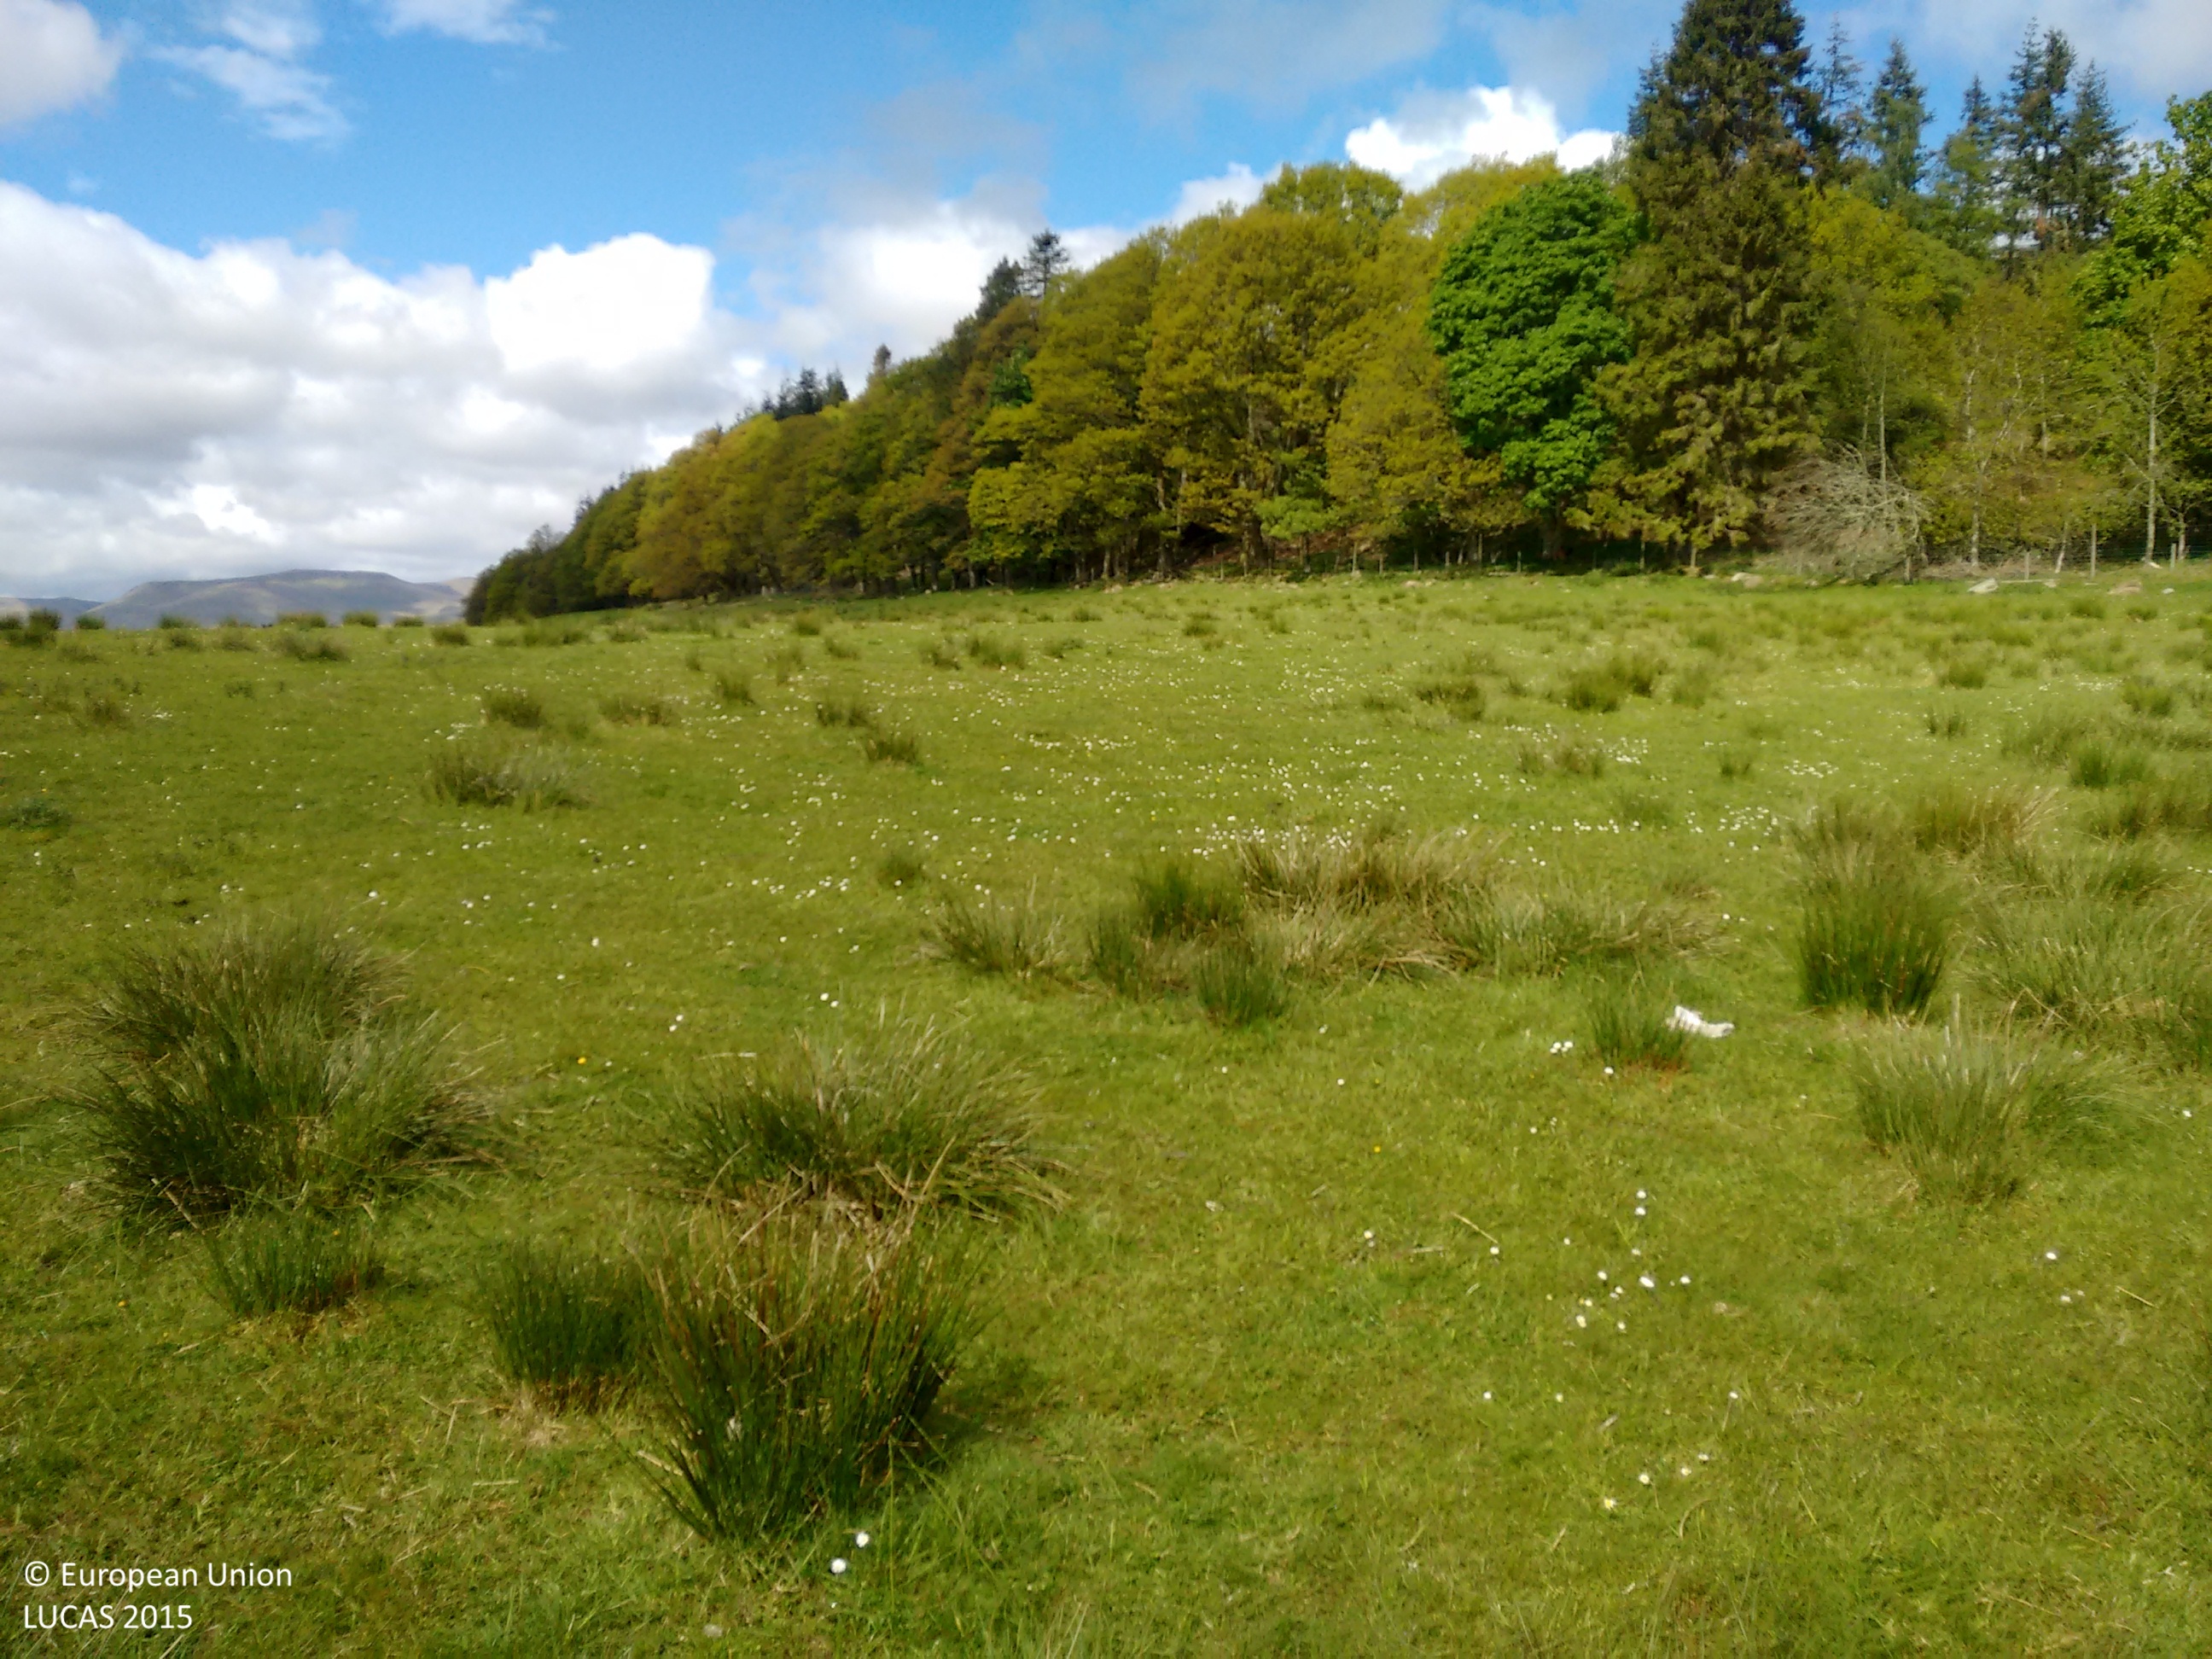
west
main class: Grassland
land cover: Grassland without tree/shrub cover
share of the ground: > 75 %
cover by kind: herbaceous plants 100 %
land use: Agriculture (excluding fallow land and kitchen gardens)
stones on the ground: < 10 %
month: May
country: GB
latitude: 56.3491
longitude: -3.9850
